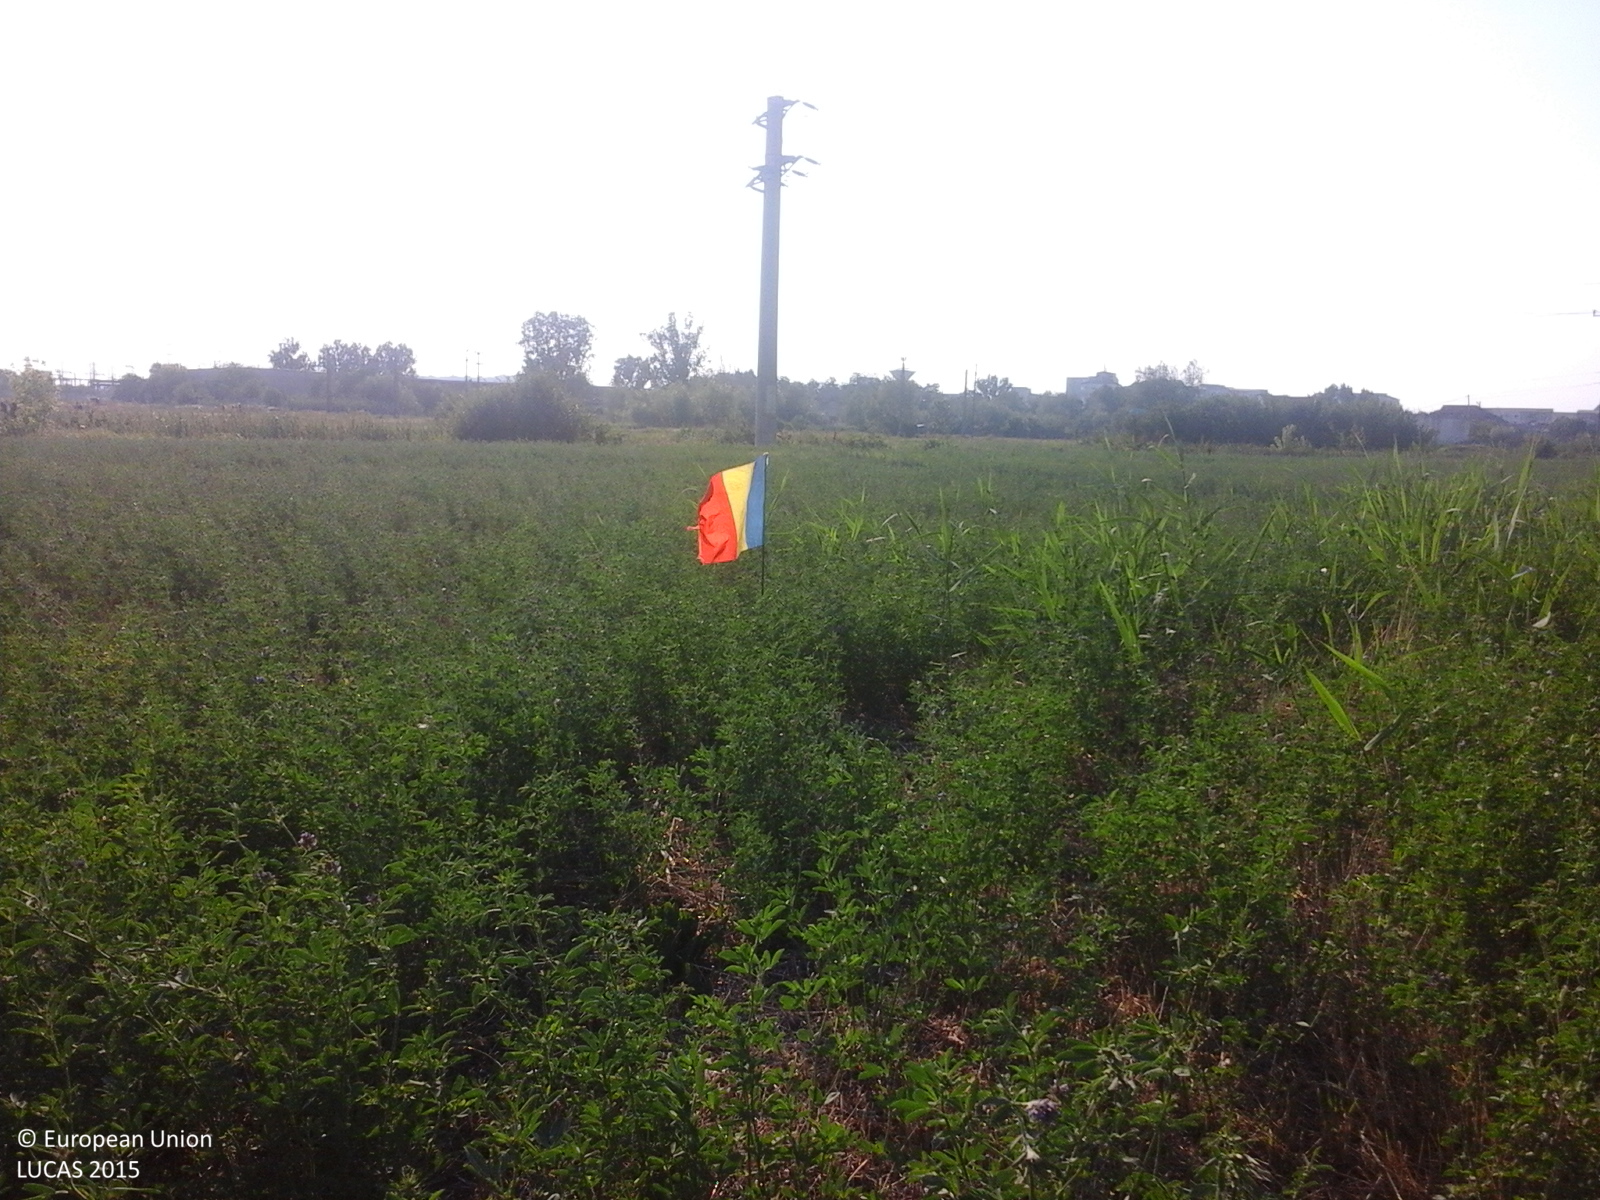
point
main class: Cropland
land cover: Lucerne
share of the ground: > 75 %
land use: Agriculture (excluding fallow land and kitchen gardens)
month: June
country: RO
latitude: 46.6223
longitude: 27.7363
